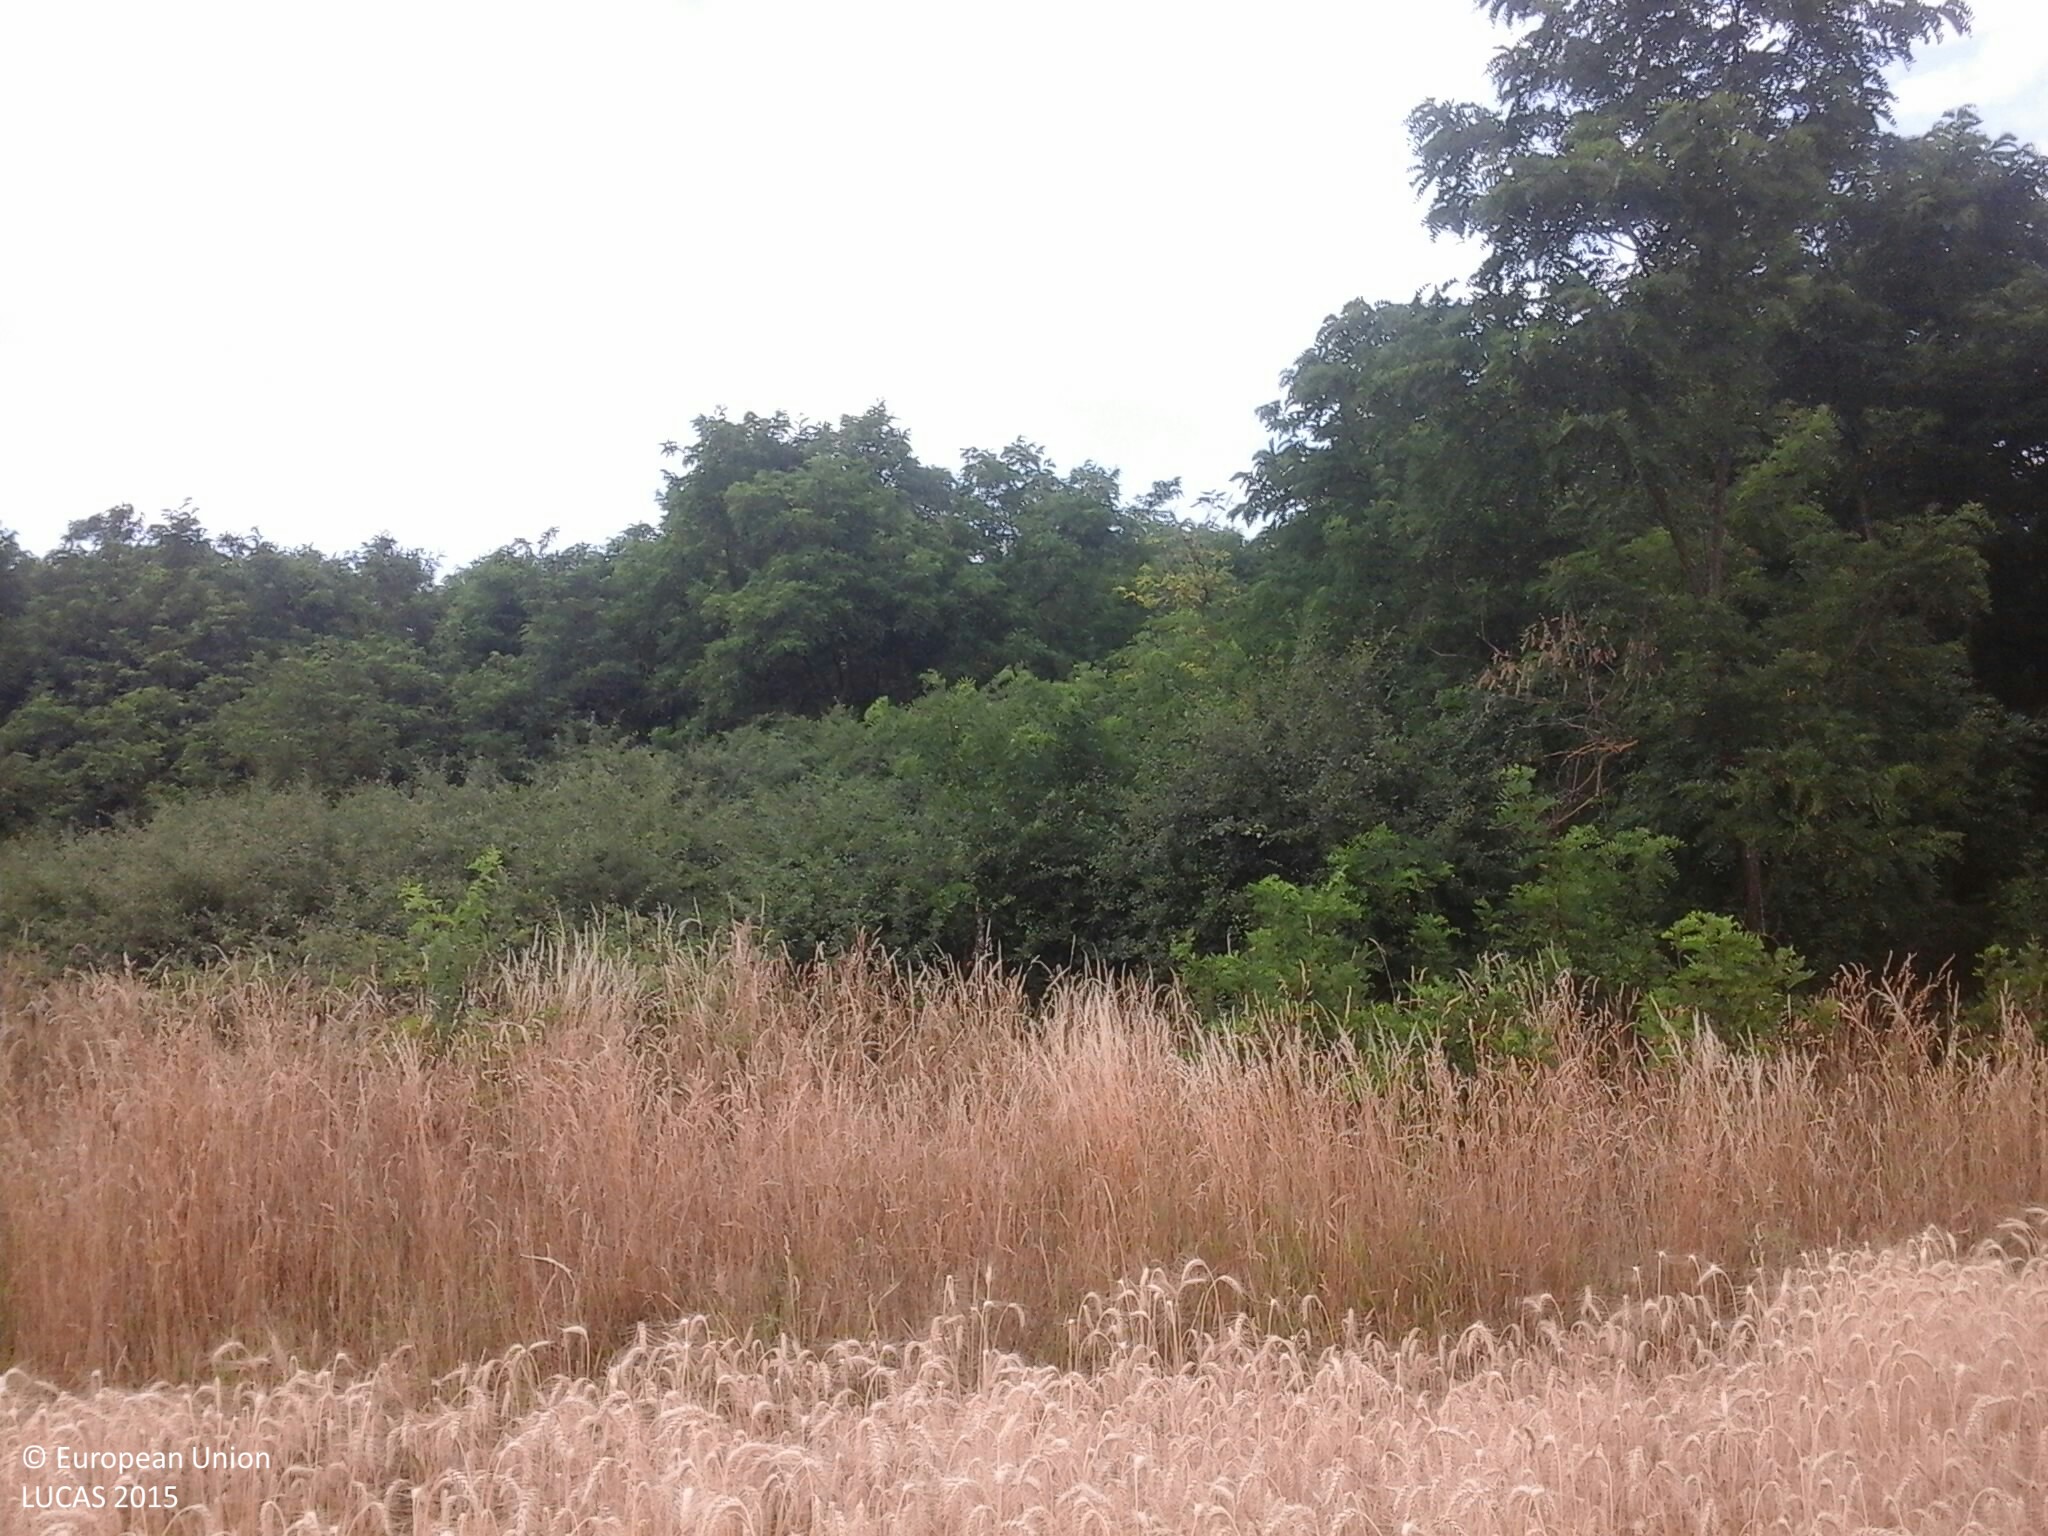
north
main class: Cropland
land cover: Common wheat
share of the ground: > 75 %
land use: Agriculture (excluding fallow land and kitchen gardens)
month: July
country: HU
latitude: 47.2629
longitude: 17.2352
